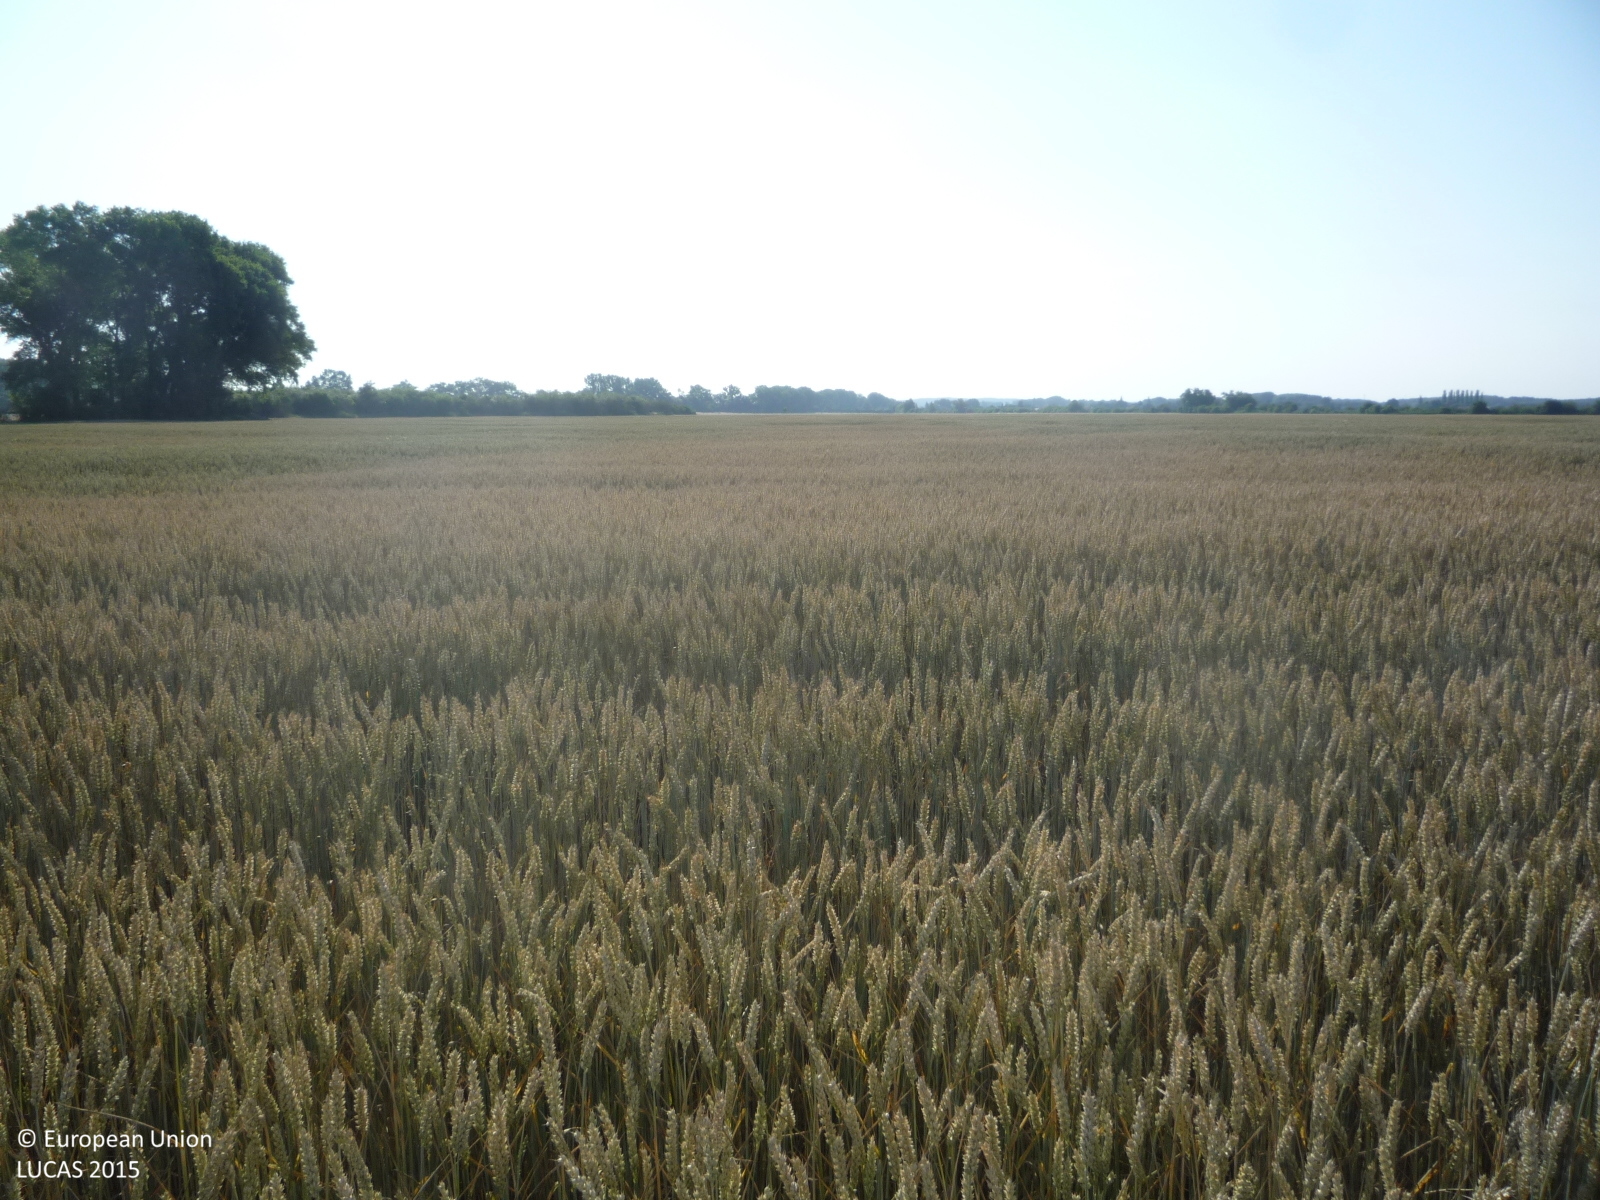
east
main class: Cropland
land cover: Common wheat
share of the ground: > 75 %
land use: Agriculture (excluding fallow land and kitchen gardens)
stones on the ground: < 10 %
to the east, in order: Common wheat
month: July
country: CZ
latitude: 50.1380
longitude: 15.1940
